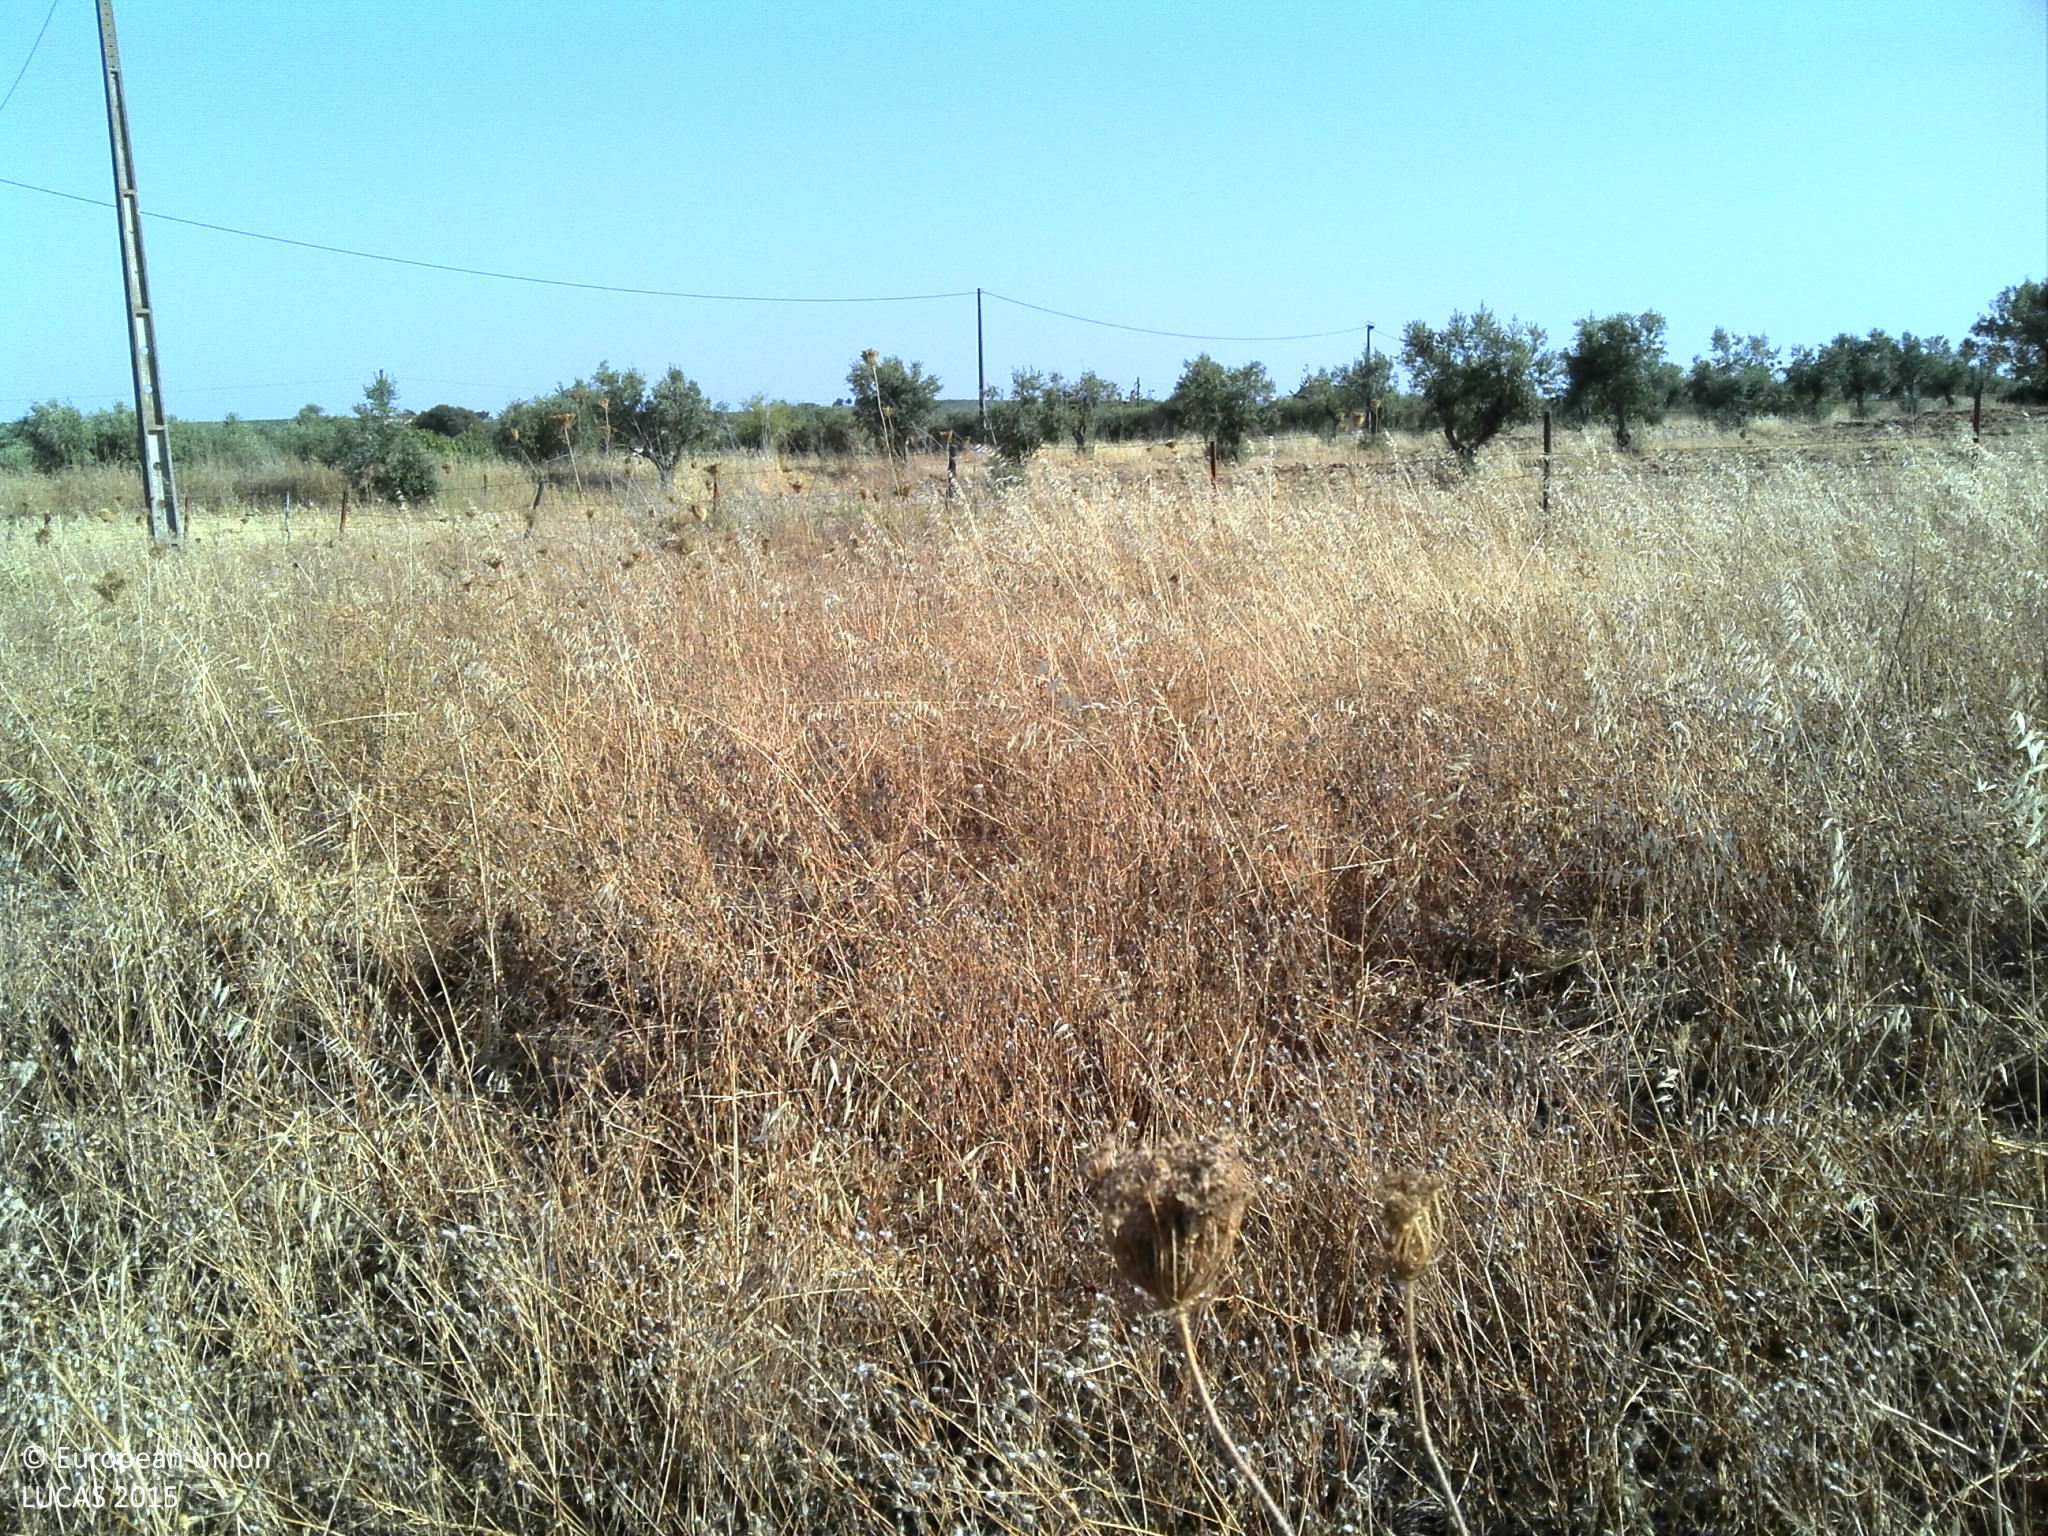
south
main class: Grassland
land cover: Grassland without tree/shrub cover
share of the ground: > 75 %
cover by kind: herbaceous plants 100 %
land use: Agriculture (excluding fallow land and kitchen gardens)
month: June
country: PT
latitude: 38.2810
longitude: -7.3634
